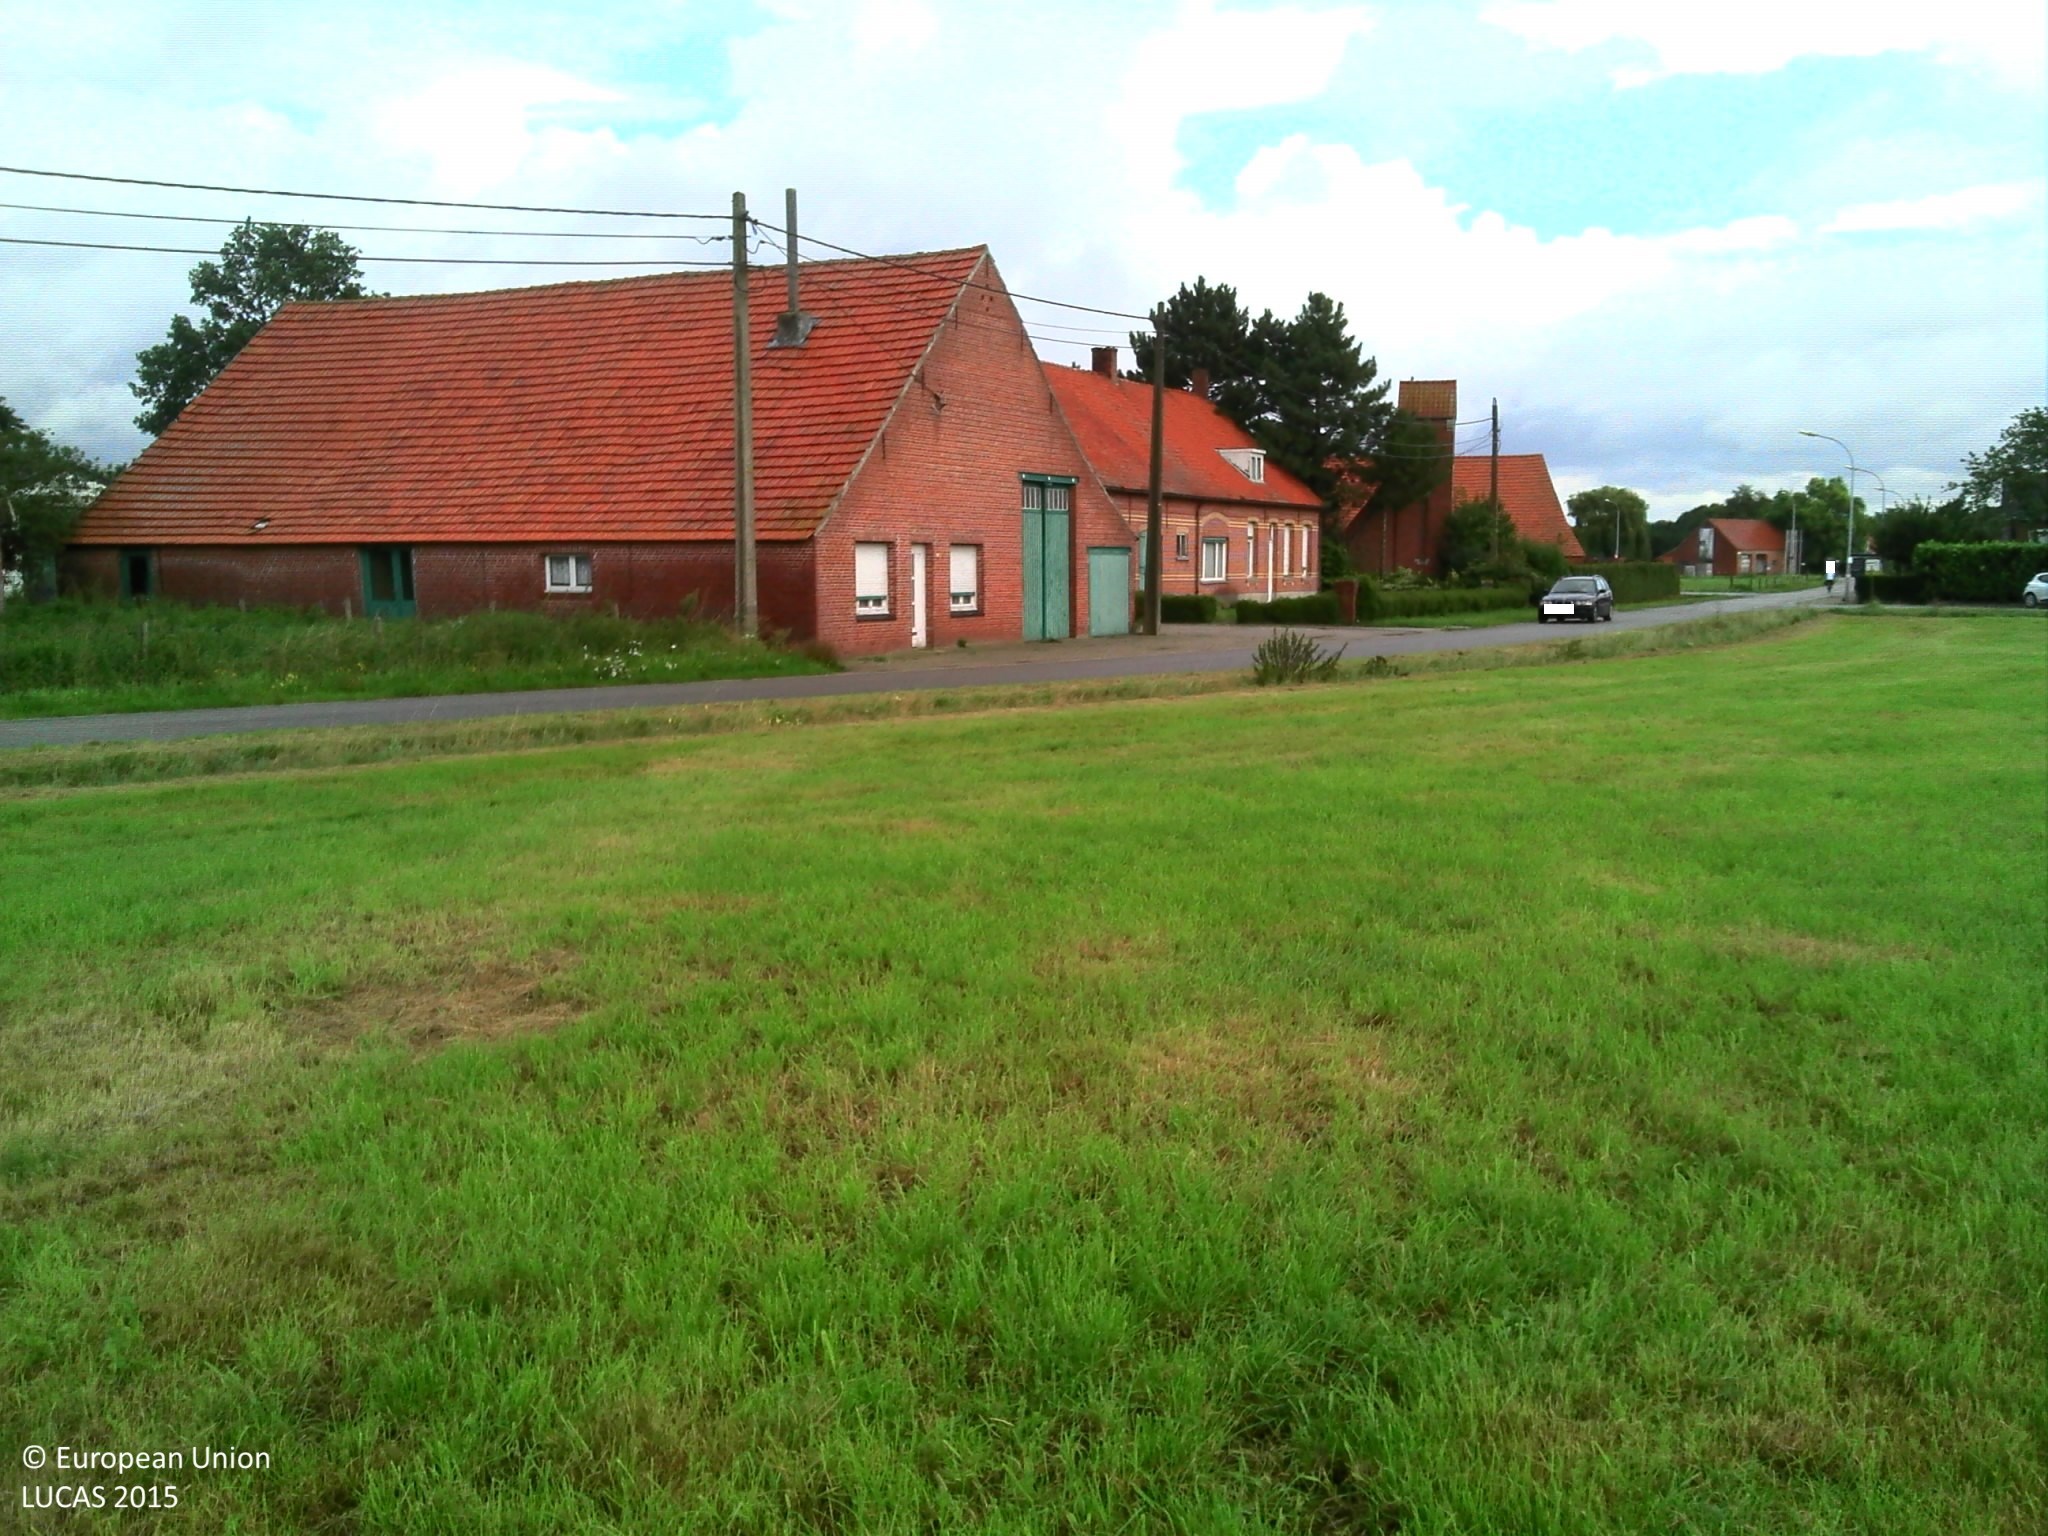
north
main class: Grassland
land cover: Grassland without tree/shrub cover
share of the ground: > 75 %
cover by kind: herbaceous plants 100 %
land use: Agriculture (excluding fallow land and kitchen gardens)
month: September
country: BE
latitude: 51.4325
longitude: 4.7462
